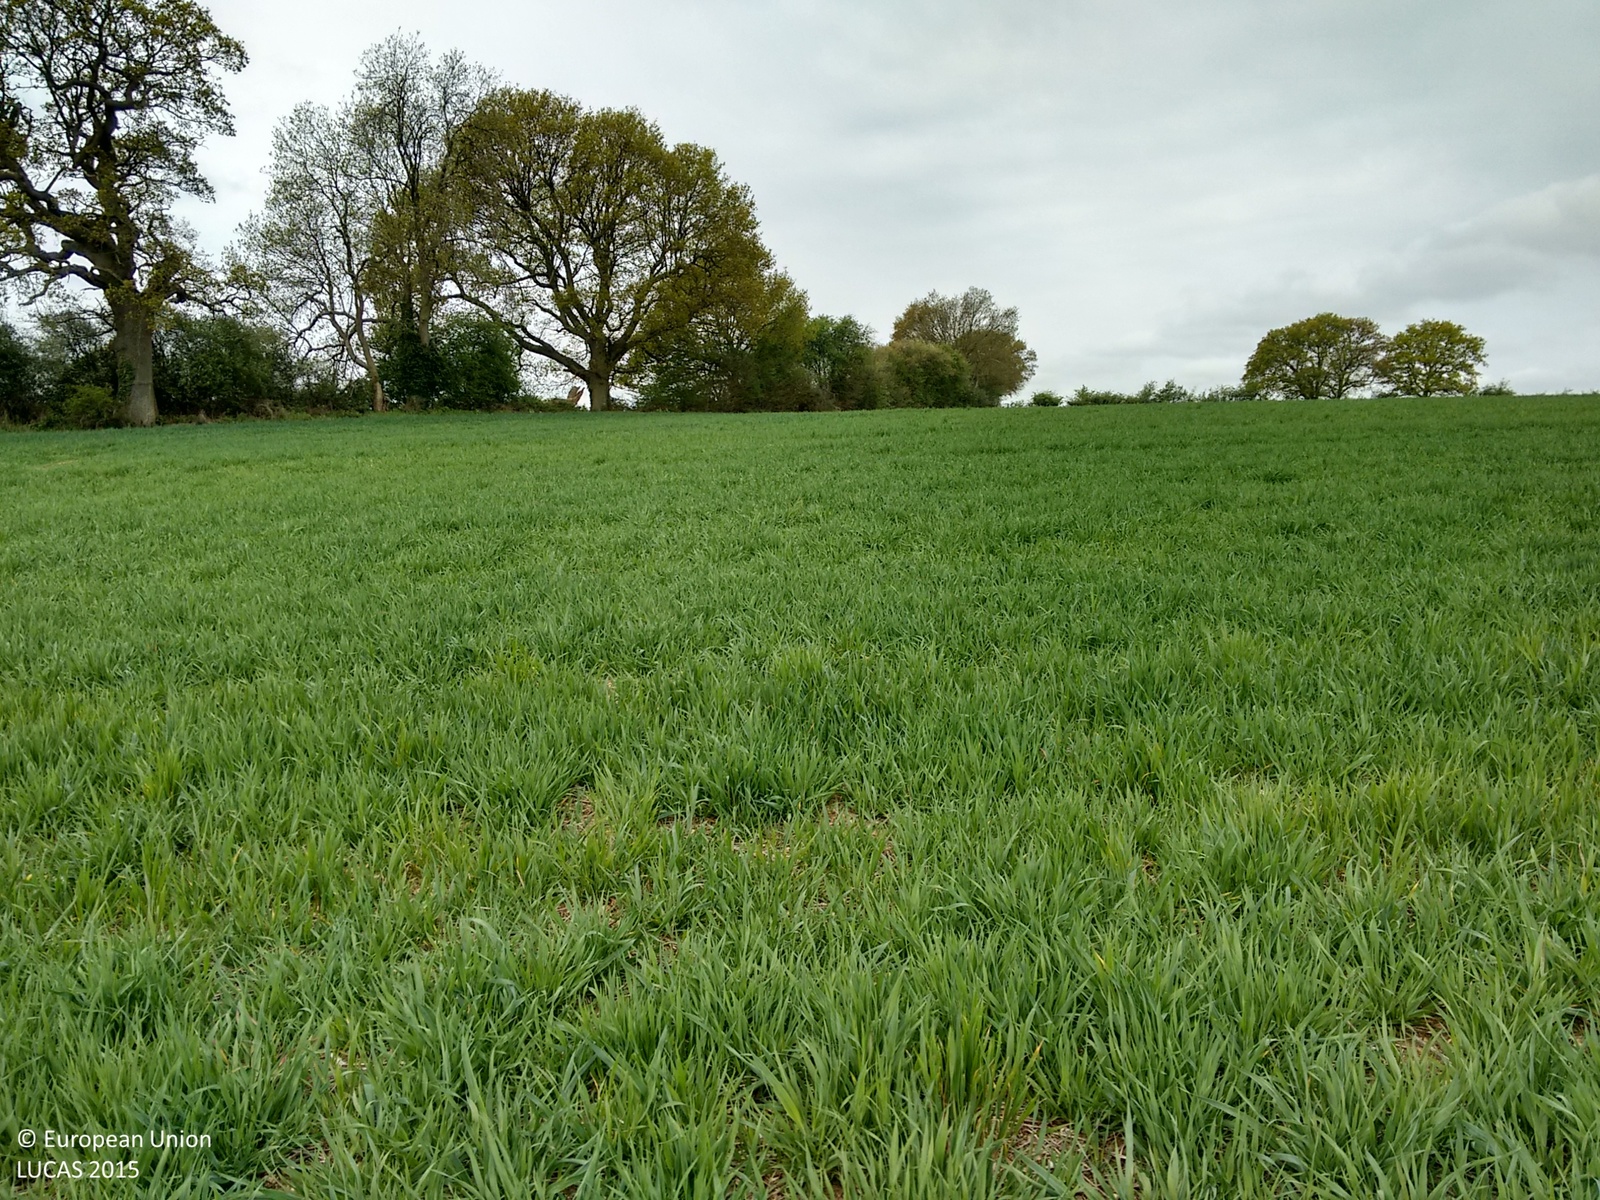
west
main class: Cropland
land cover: Oats
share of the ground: 50 - 75 %
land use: Agriculture (excluding fallow land and kitchen gardens)
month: May
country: GB
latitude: 51.1584
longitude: -0.9826
